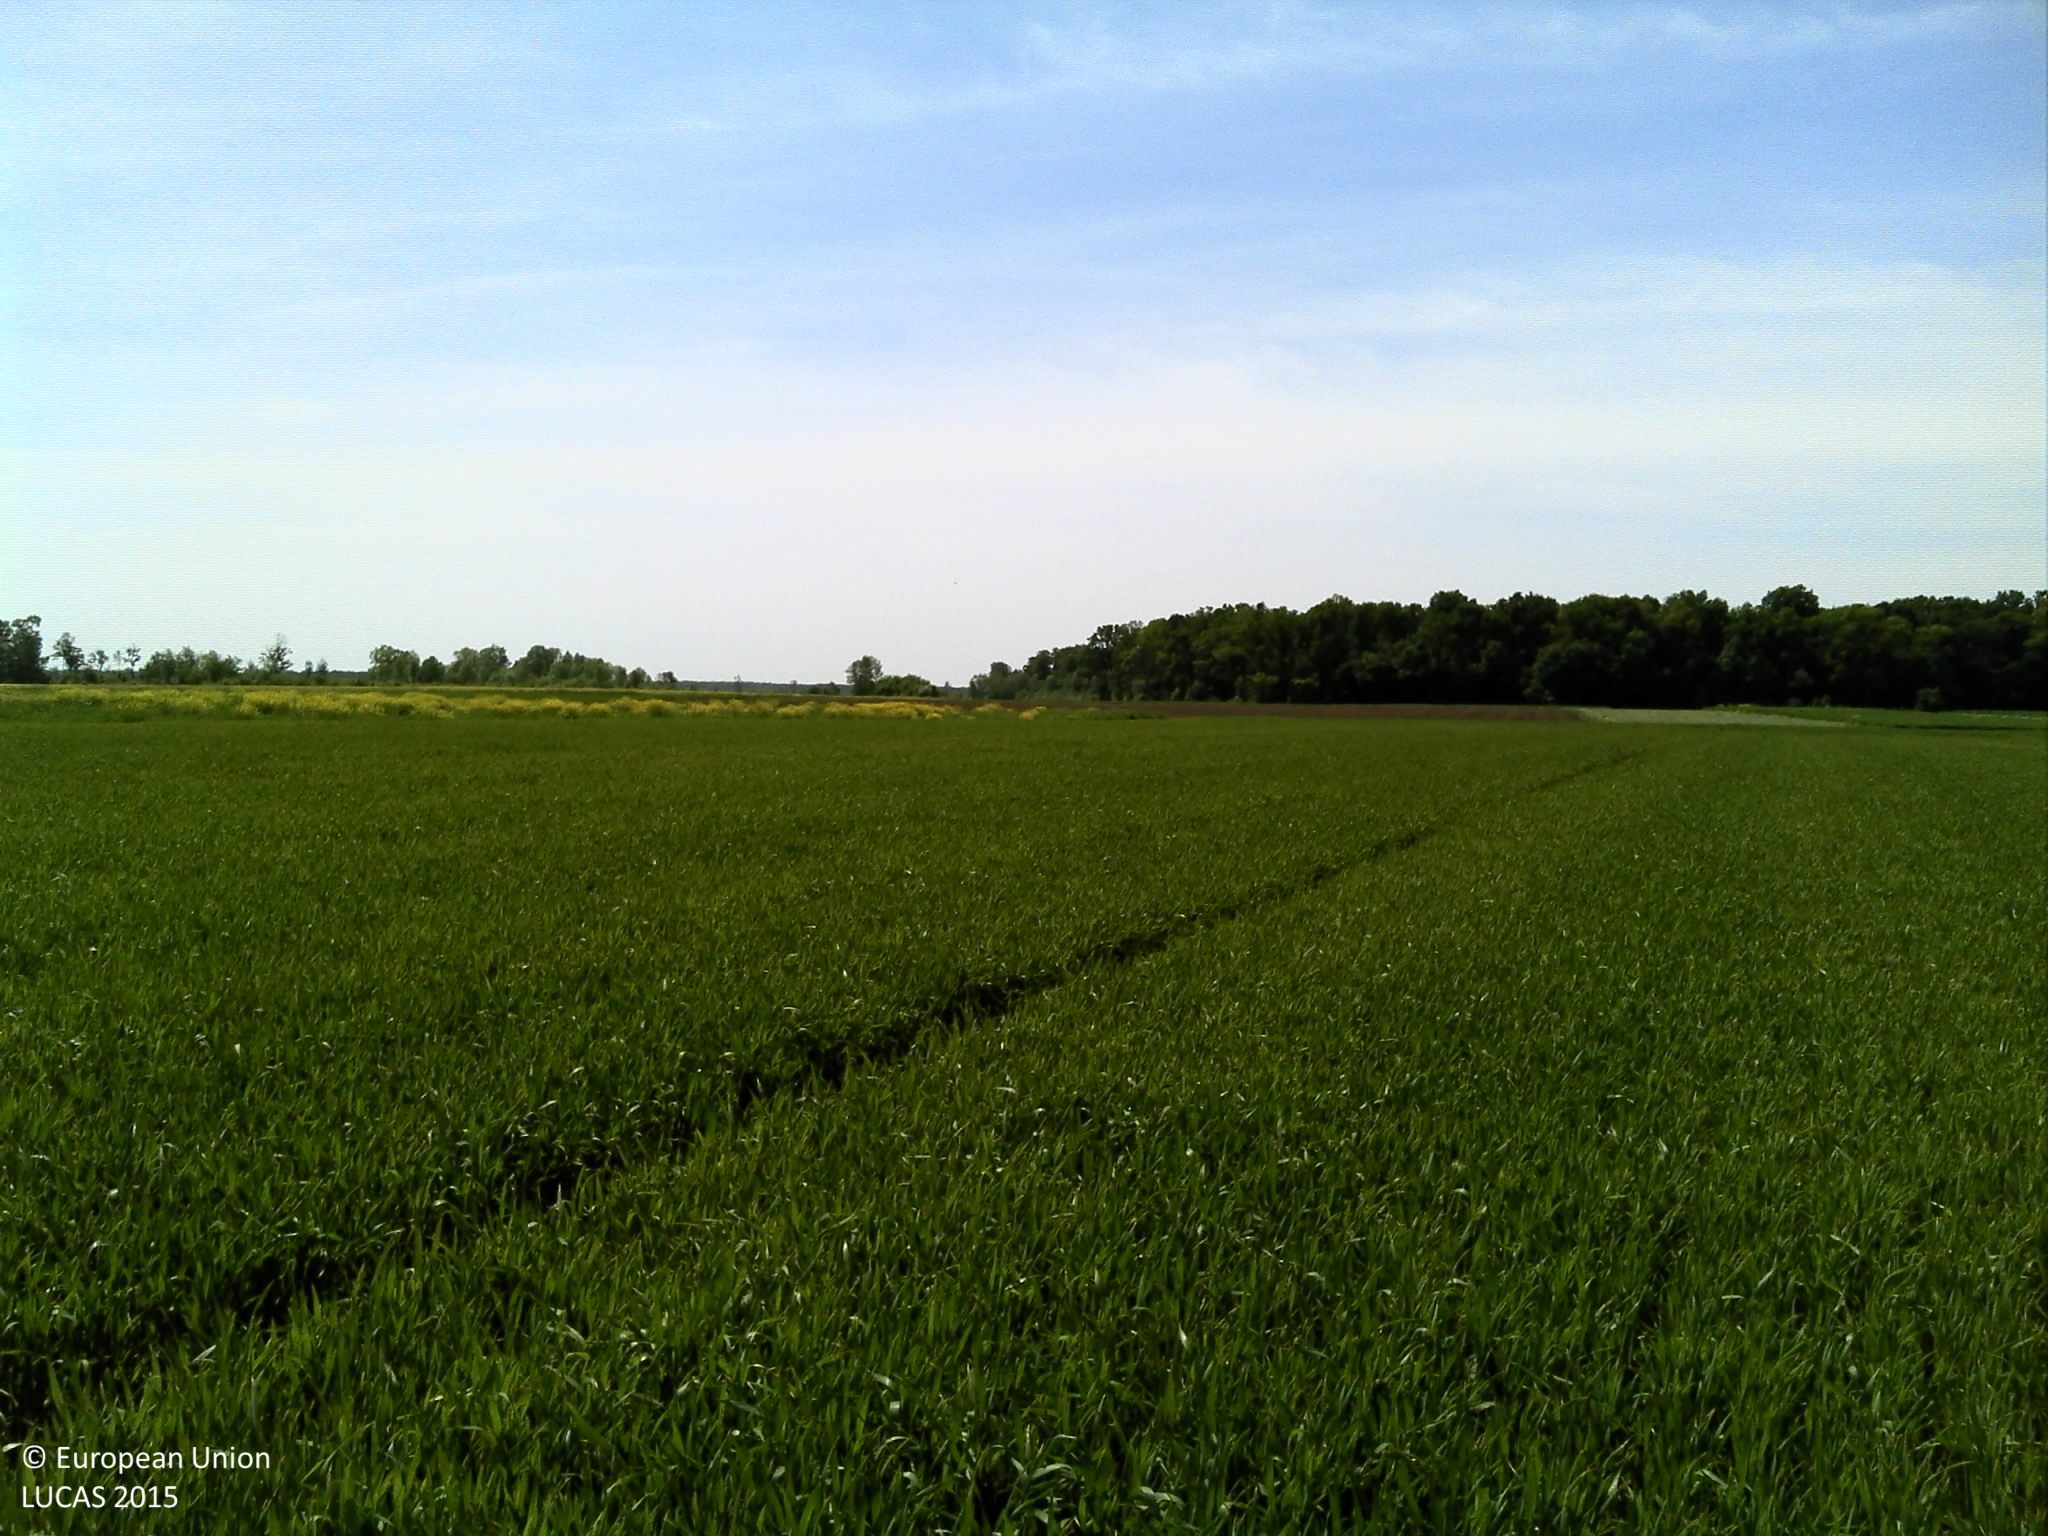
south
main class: Cropland
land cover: Common wheat
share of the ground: > 75 %
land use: Agriculture (excluding fallow land and kitchen gardens)
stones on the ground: < 10 %
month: May
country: HR
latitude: 45.2378
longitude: 18.8864
